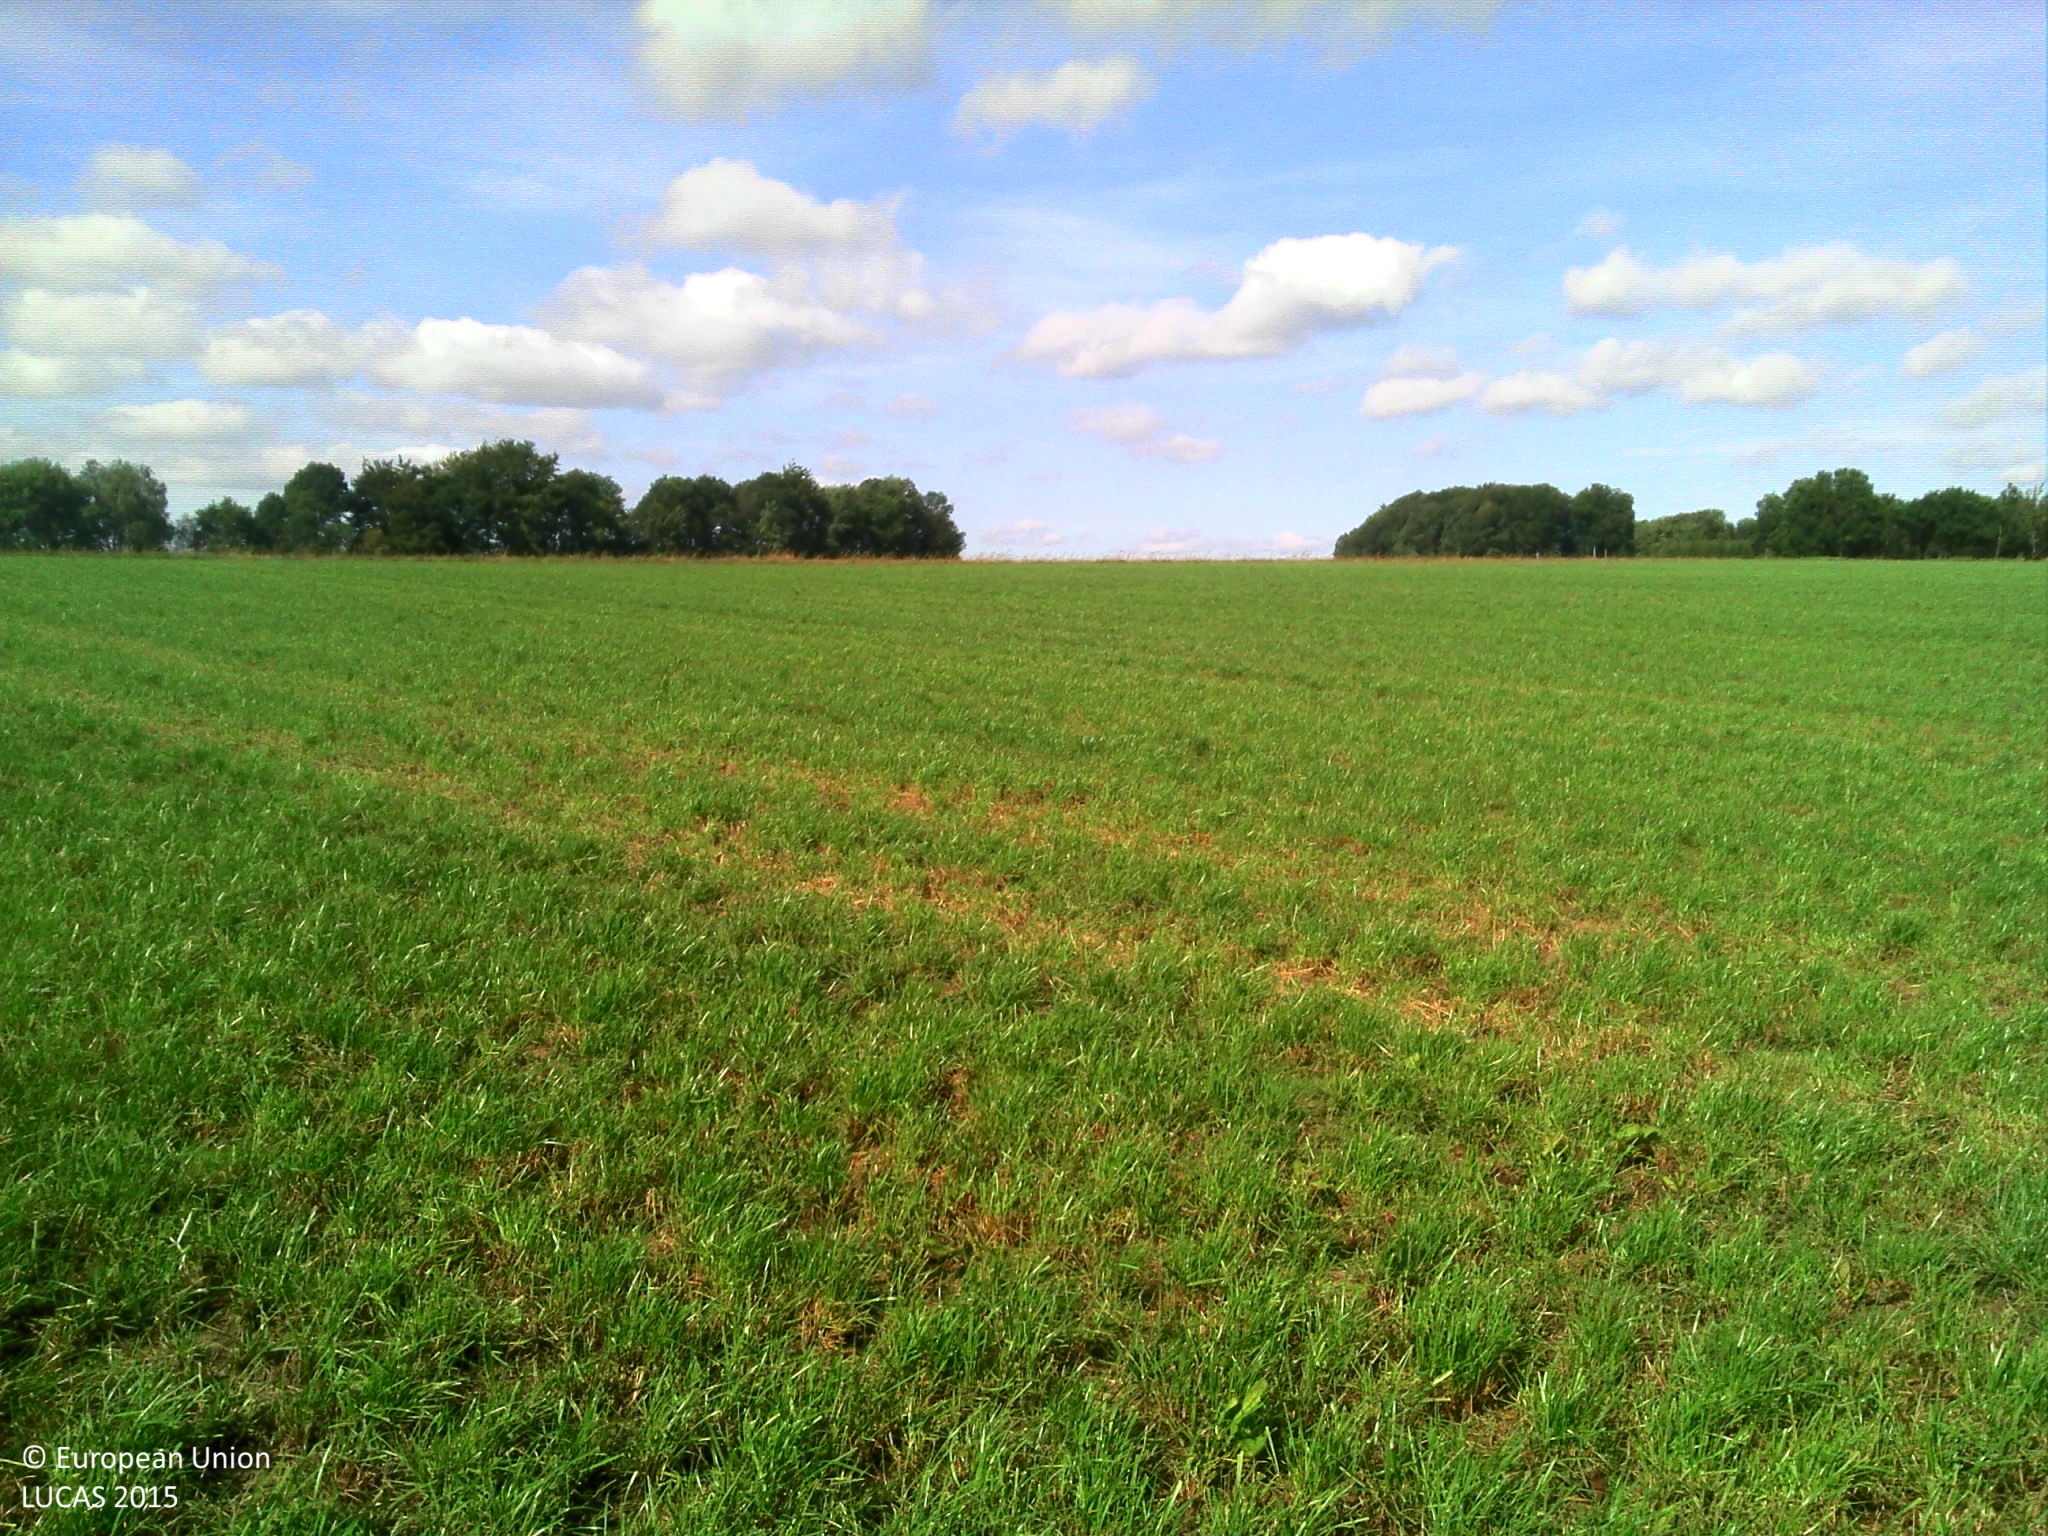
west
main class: Cropland
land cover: Temporary grasslands
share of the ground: > 75 %
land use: Agriculture (excluding fallow land and kitchen gardens)
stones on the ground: < 10 %
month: August
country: LU
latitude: 50.0747
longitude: 5.9049
